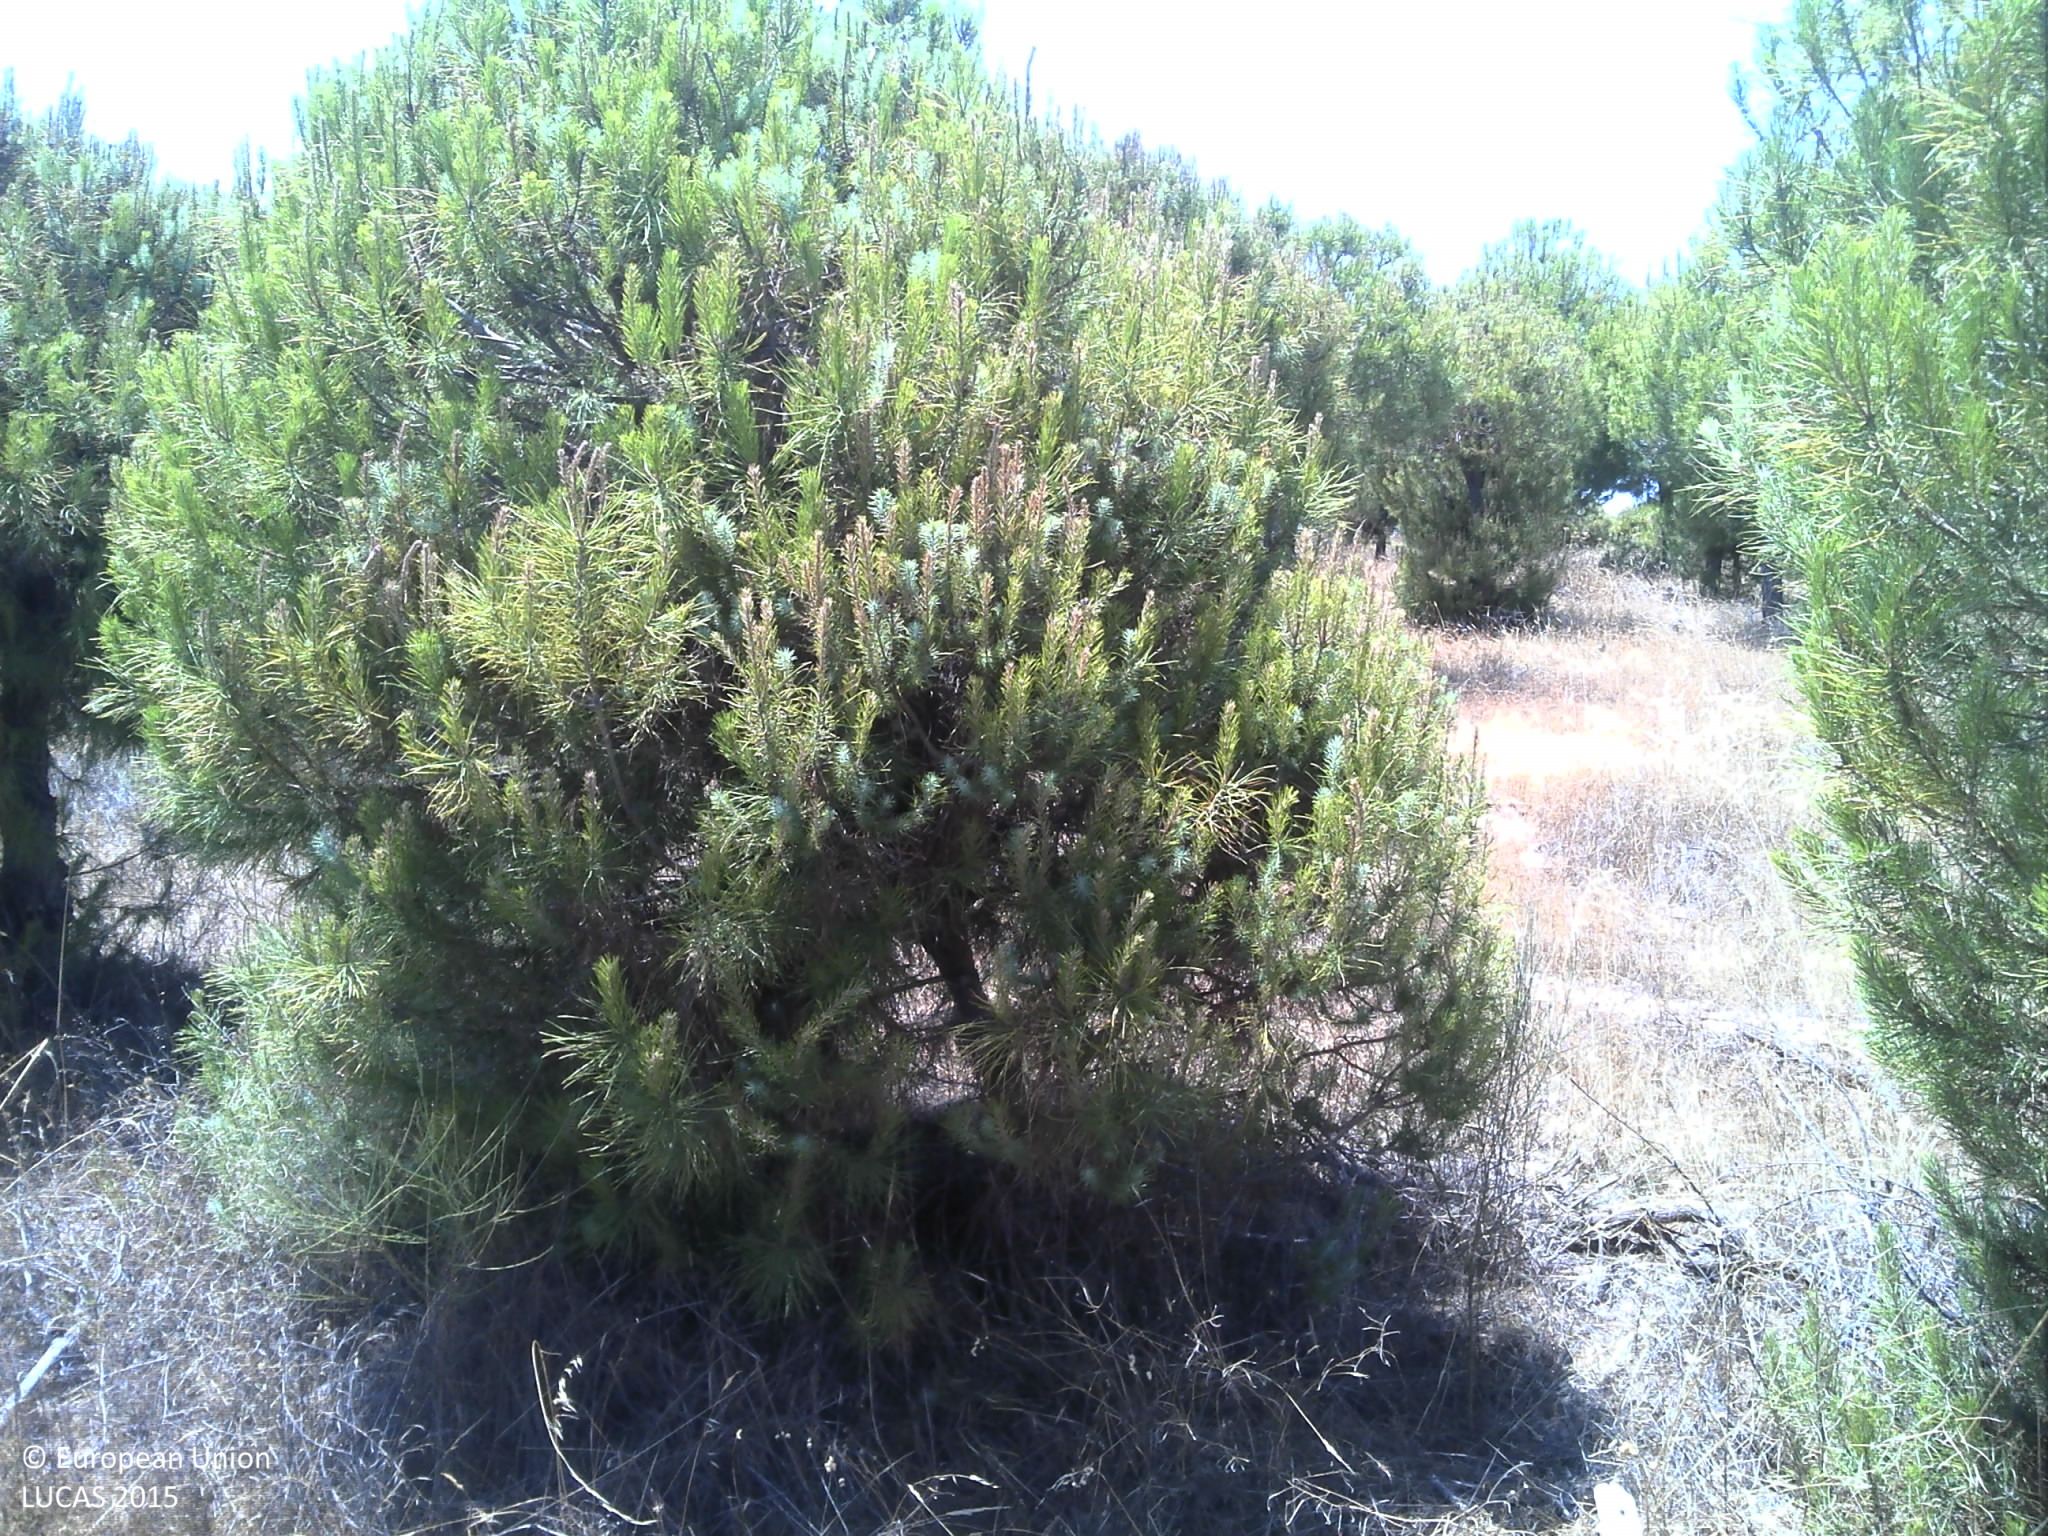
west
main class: Woodland
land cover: Pine dominated coniferous woodland
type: coniferous forest of the mediterranean region
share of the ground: 50 - 75 %
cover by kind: coniferous forest trees 50 %, herbaceous plants 30 %, unconsolidated bare surface 10 %, shrubs 5 %
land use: Forestry
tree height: < 5 m
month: June
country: PT
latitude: 39.8441
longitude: -7.1899
